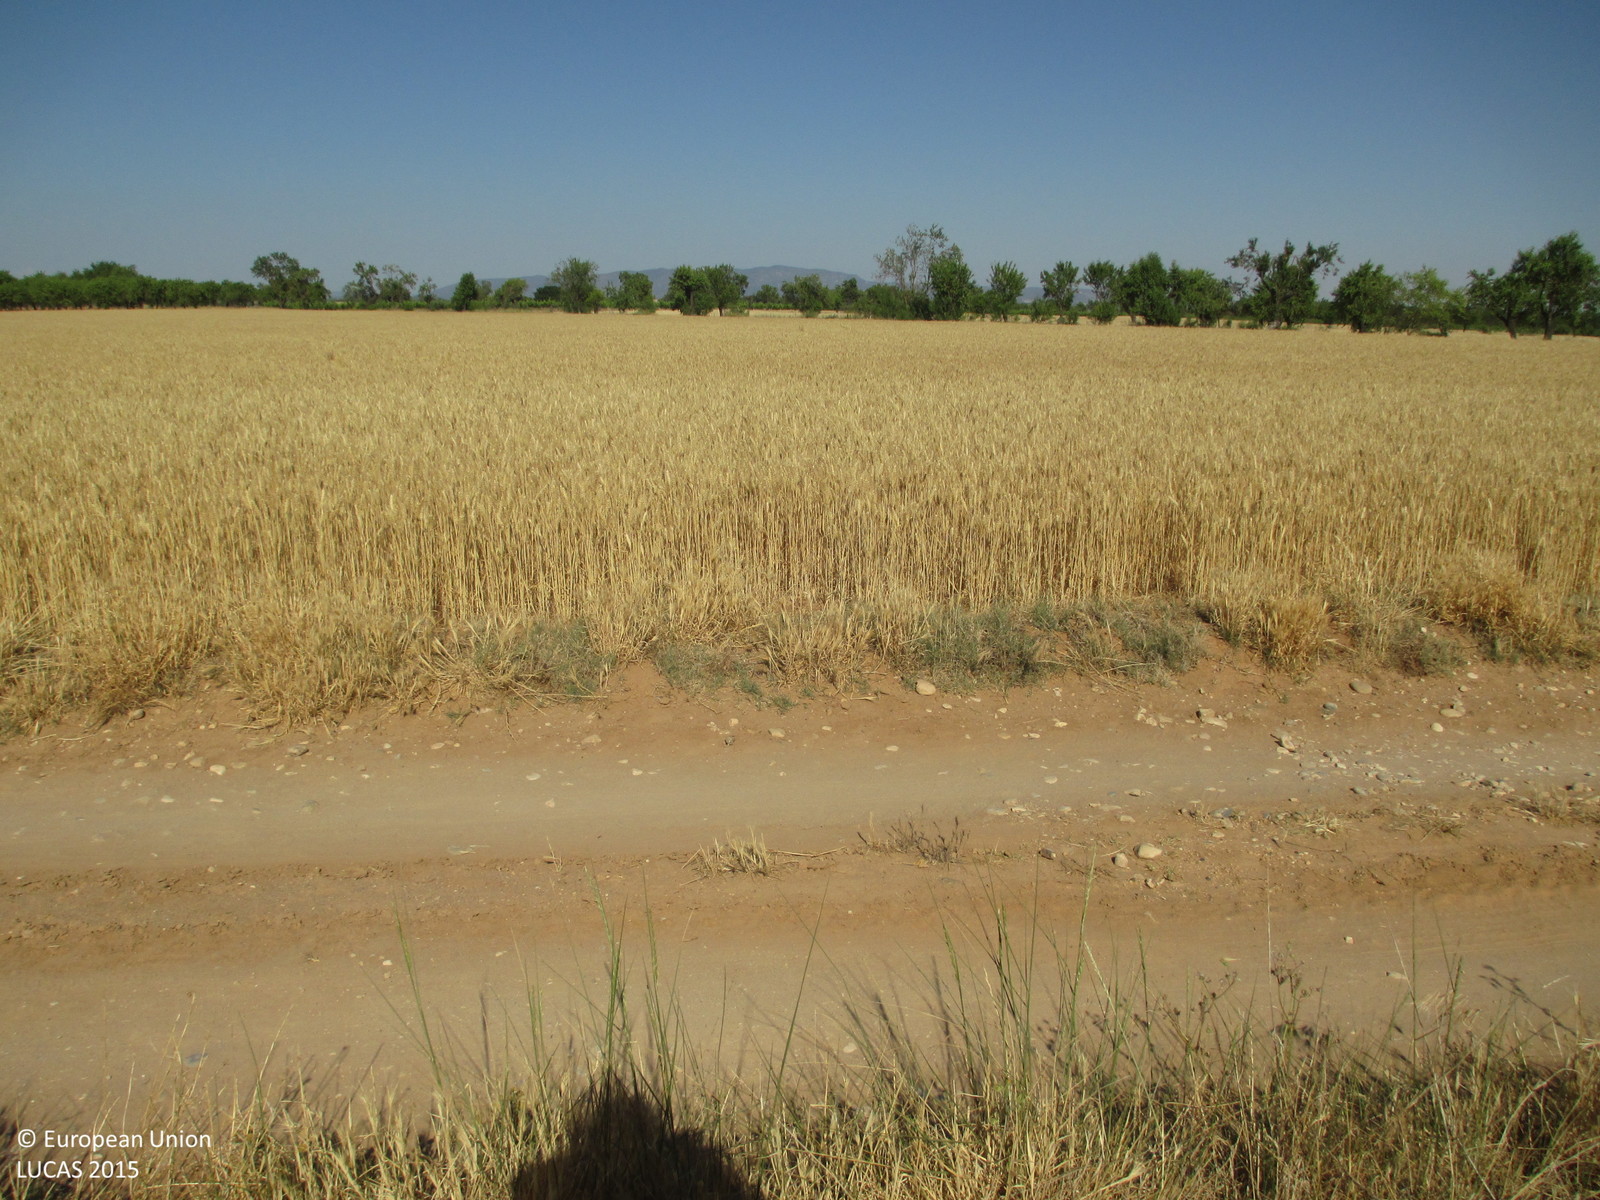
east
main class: Cropland
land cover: Vineyards
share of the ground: > 75 %
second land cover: Other bare soil
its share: > 75 %
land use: Agriculture (excluding fallow land and kitchen gardens)
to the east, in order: Vineyards; Other bare soil; Grass margins; Tracks; Grass margins; Common wheat; Groves; Shruby margins; Barley; Groves; Shruby margins; Barley; Grass margins; Vineyards; Shruby margins; Groves; Other leguminous and mixtures for fodder
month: June
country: ES
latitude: 42.0883
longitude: 0.0311
